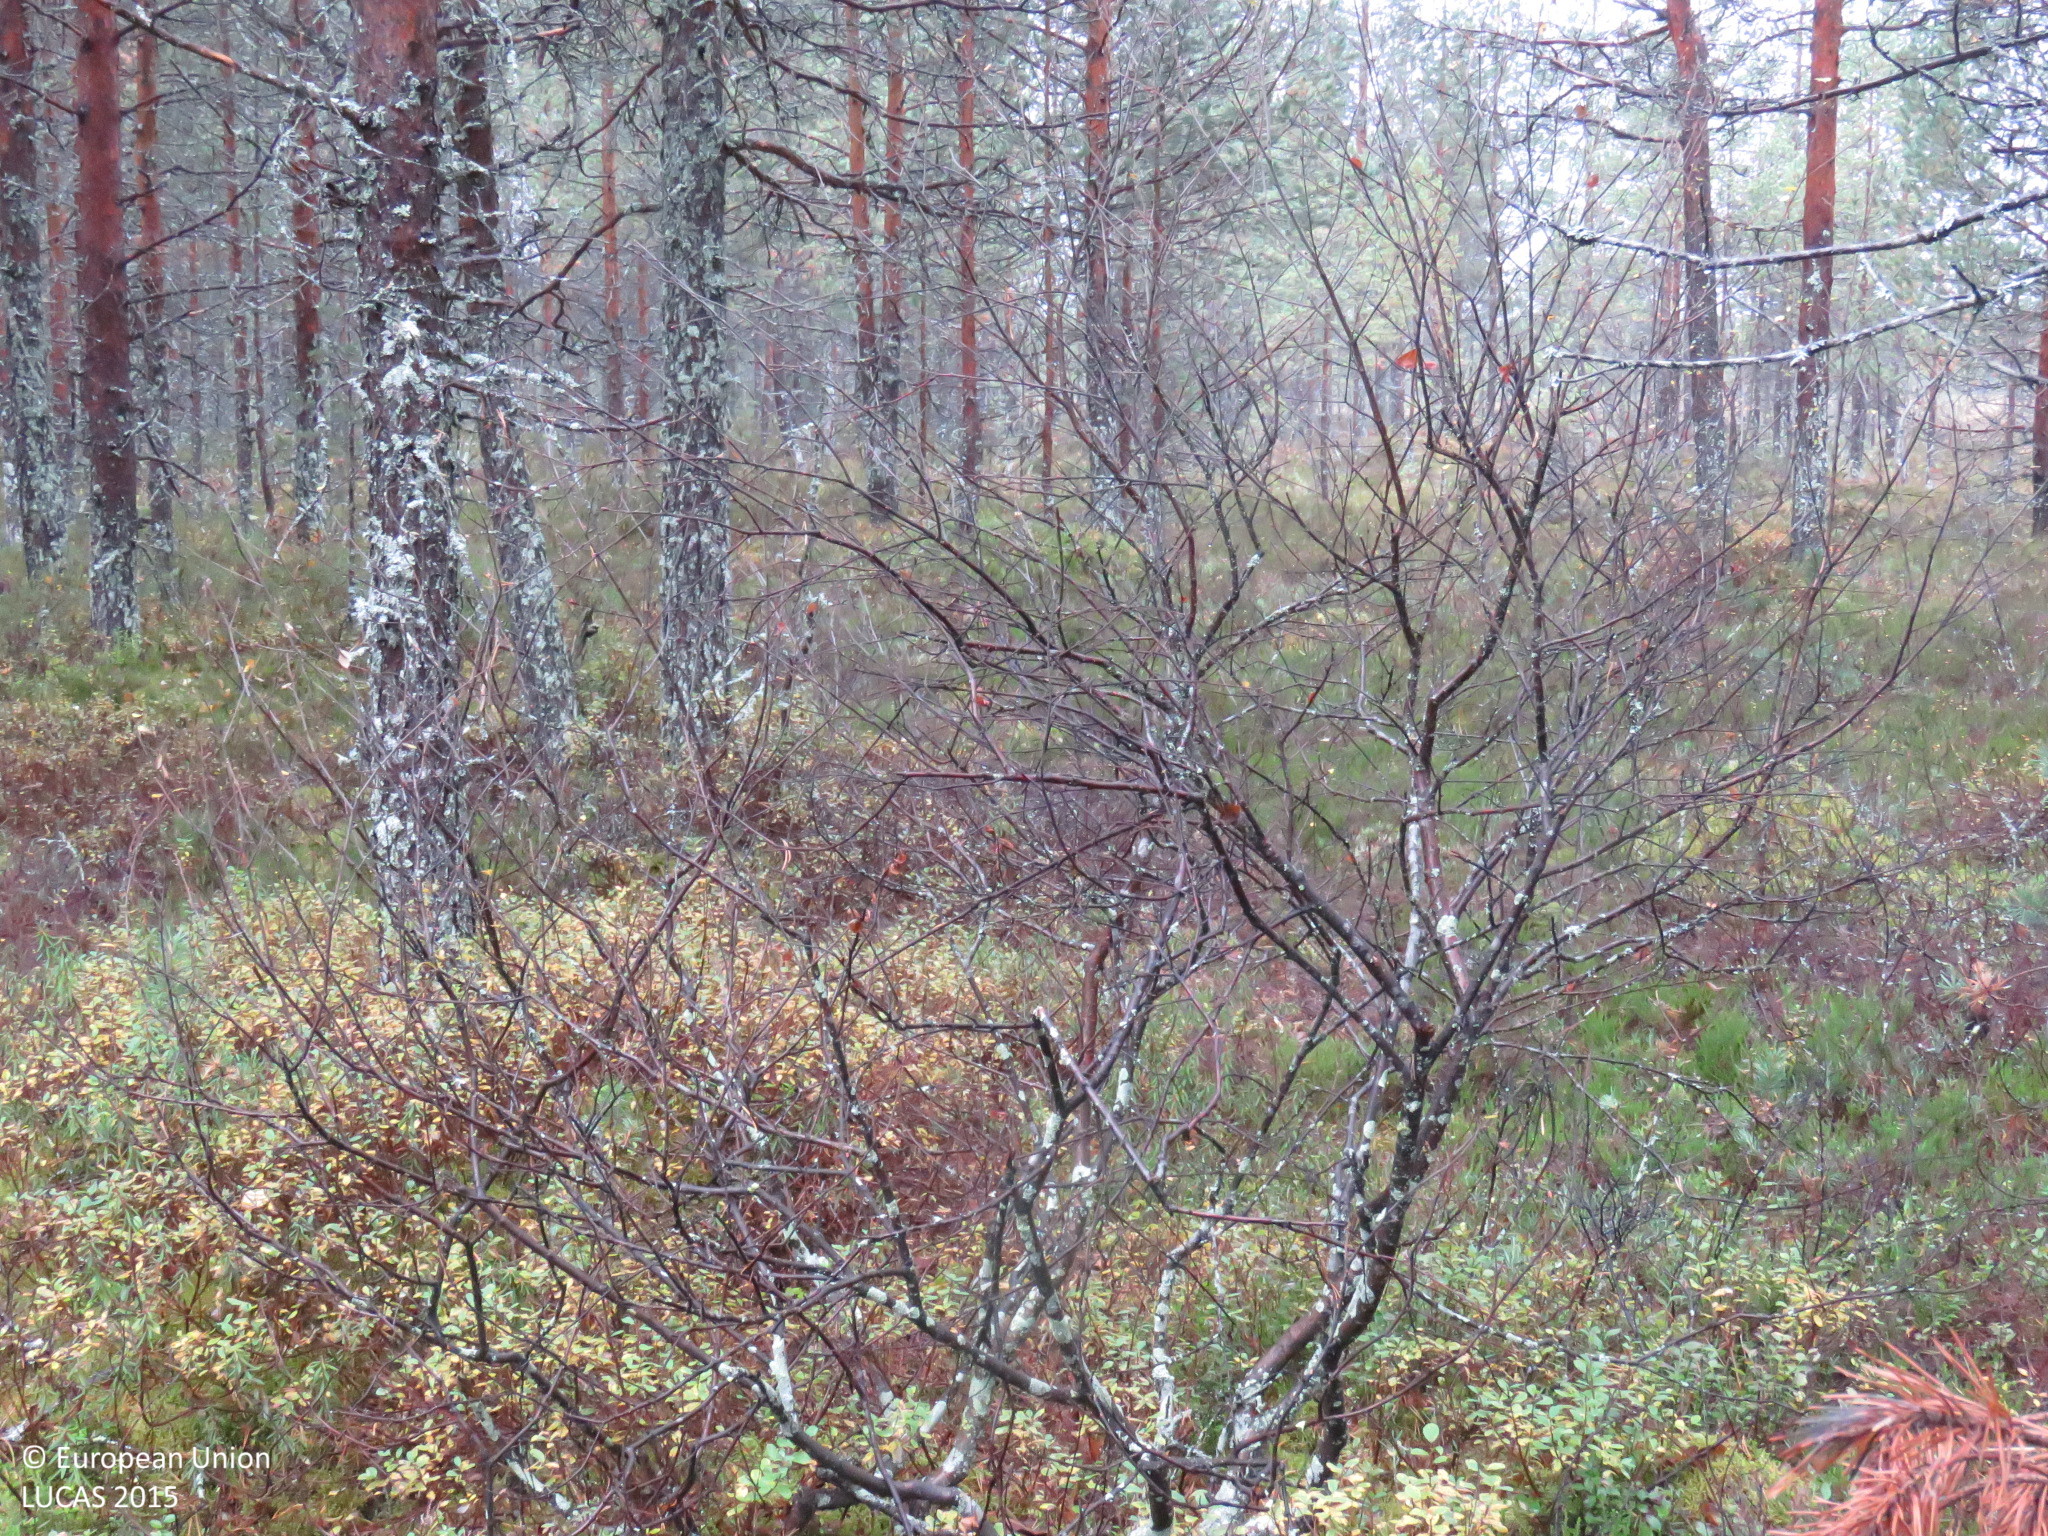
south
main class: Woodland
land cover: Pine dominated coniferous woodland
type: boreal forest
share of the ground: > 75 %
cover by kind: coniferous forest trees 70 %, shrubs 20 %, broadleaved forest trees 5 %, lichens and mosses 5 %
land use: Forestry
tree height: > 5 m
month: September
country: FI
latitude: 65.1352
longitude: 26.5407
